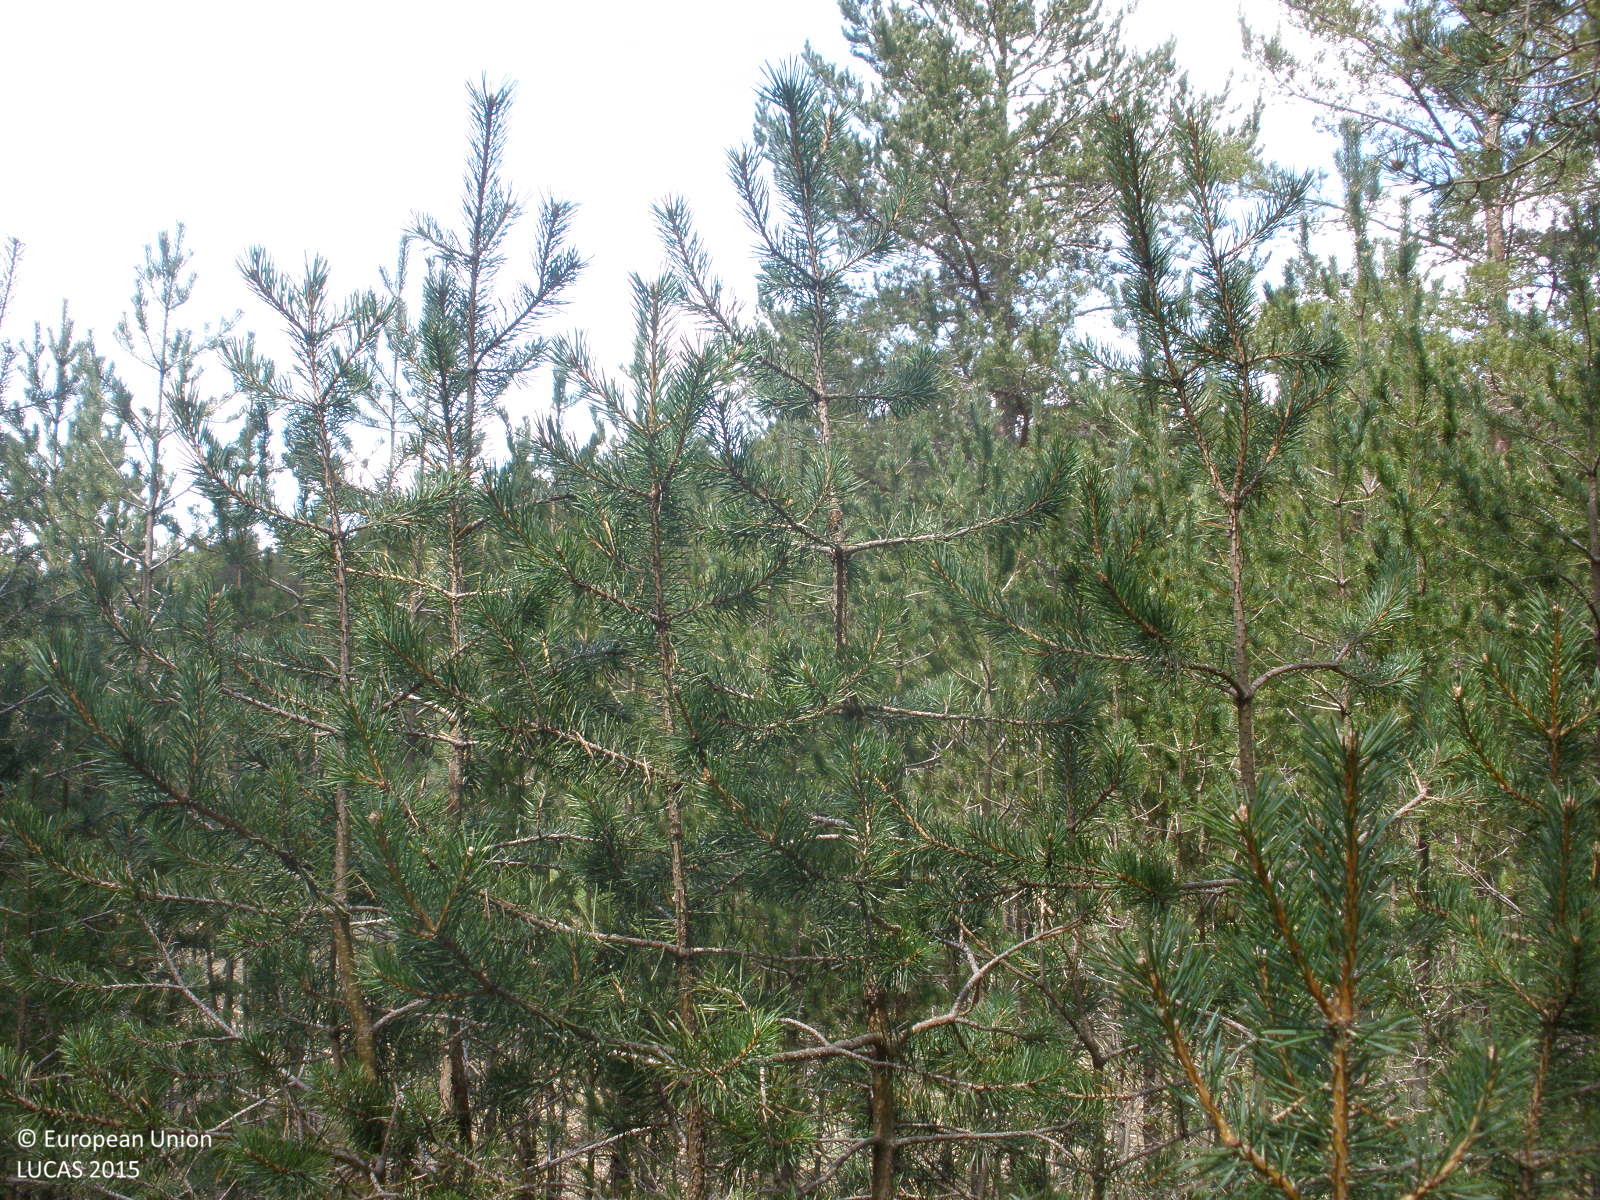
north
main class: Woodland
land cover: Pine dominated coniferous woodland
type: coniferous forest of the mediterranean region
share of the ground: > 75 %
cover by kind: coniferous forest trees 70 %, herbaceous plants 30 %
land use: Semi-natural and natural areas not in use
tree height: > 5 m
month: April
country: ES
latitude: 40.4050
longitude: -0.7433
